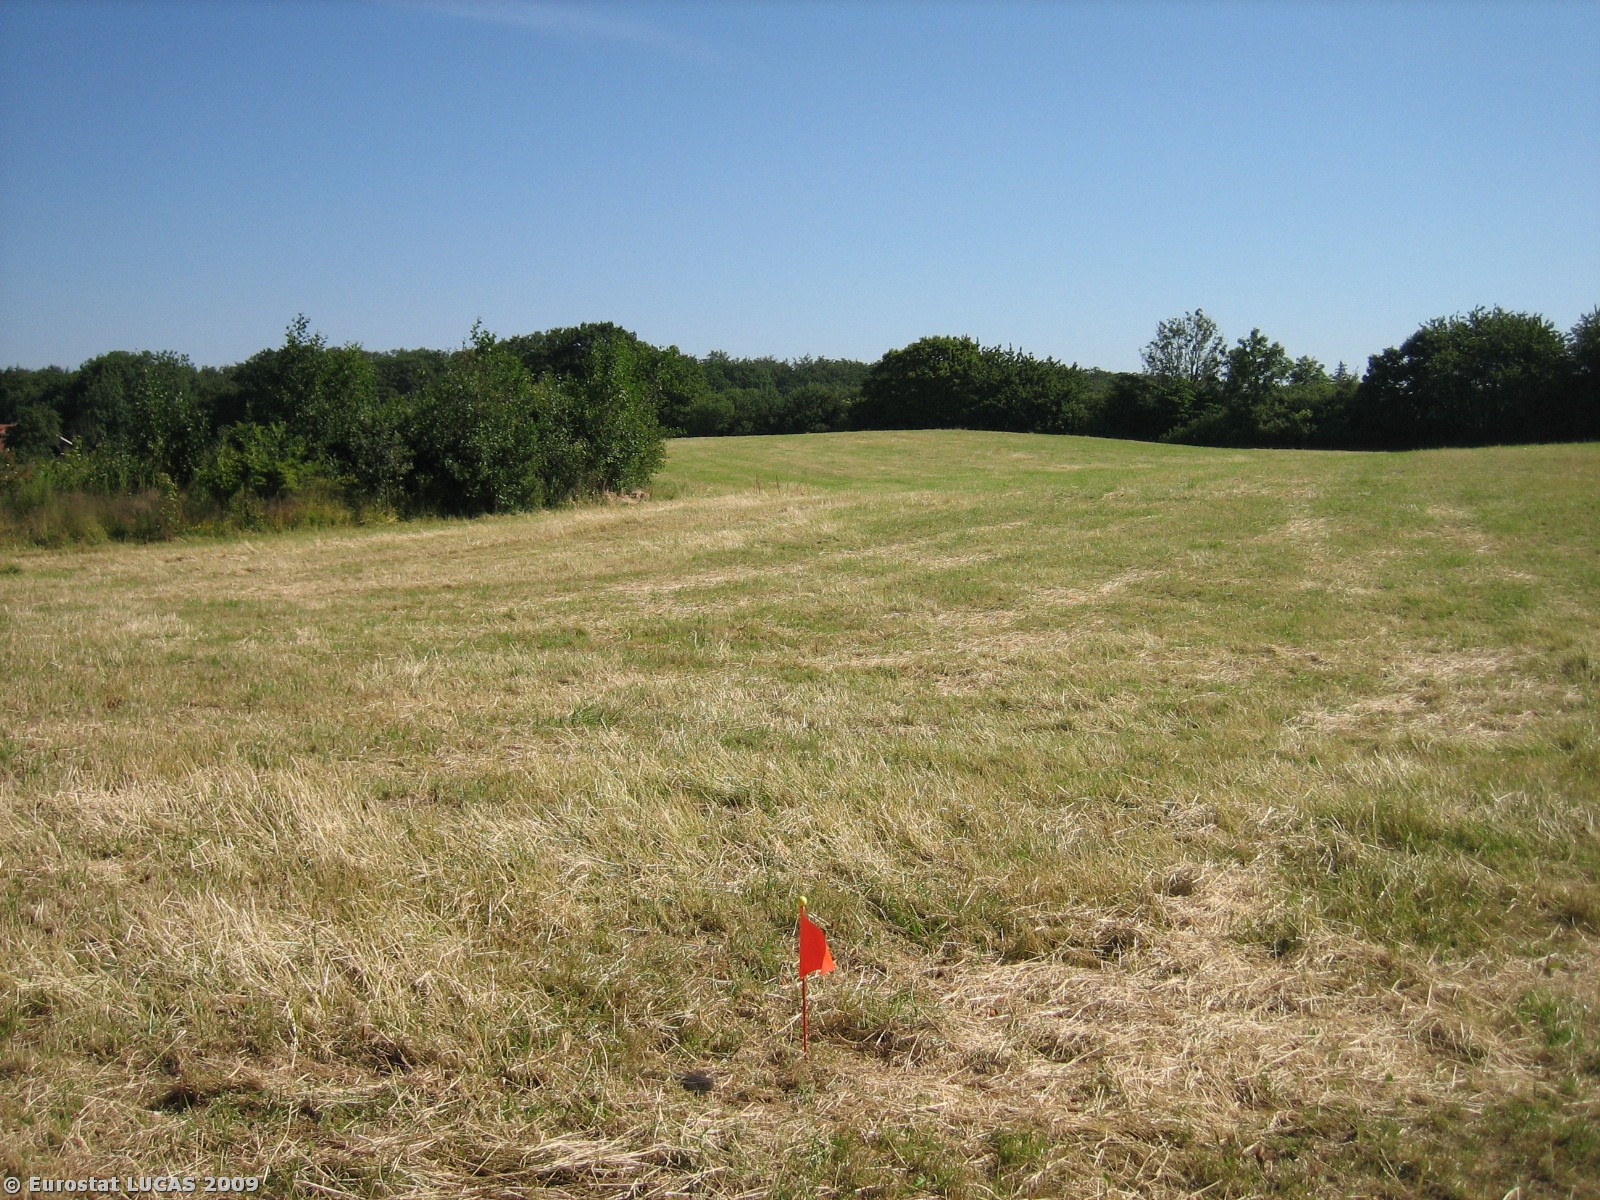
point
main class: Cropland
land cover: Temporary grasslands
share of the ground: > 75 %
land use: Agriculture (excluding fallow land and kitchen gardens)
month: June
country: DK
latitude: 55.3949
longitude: 9.2902
